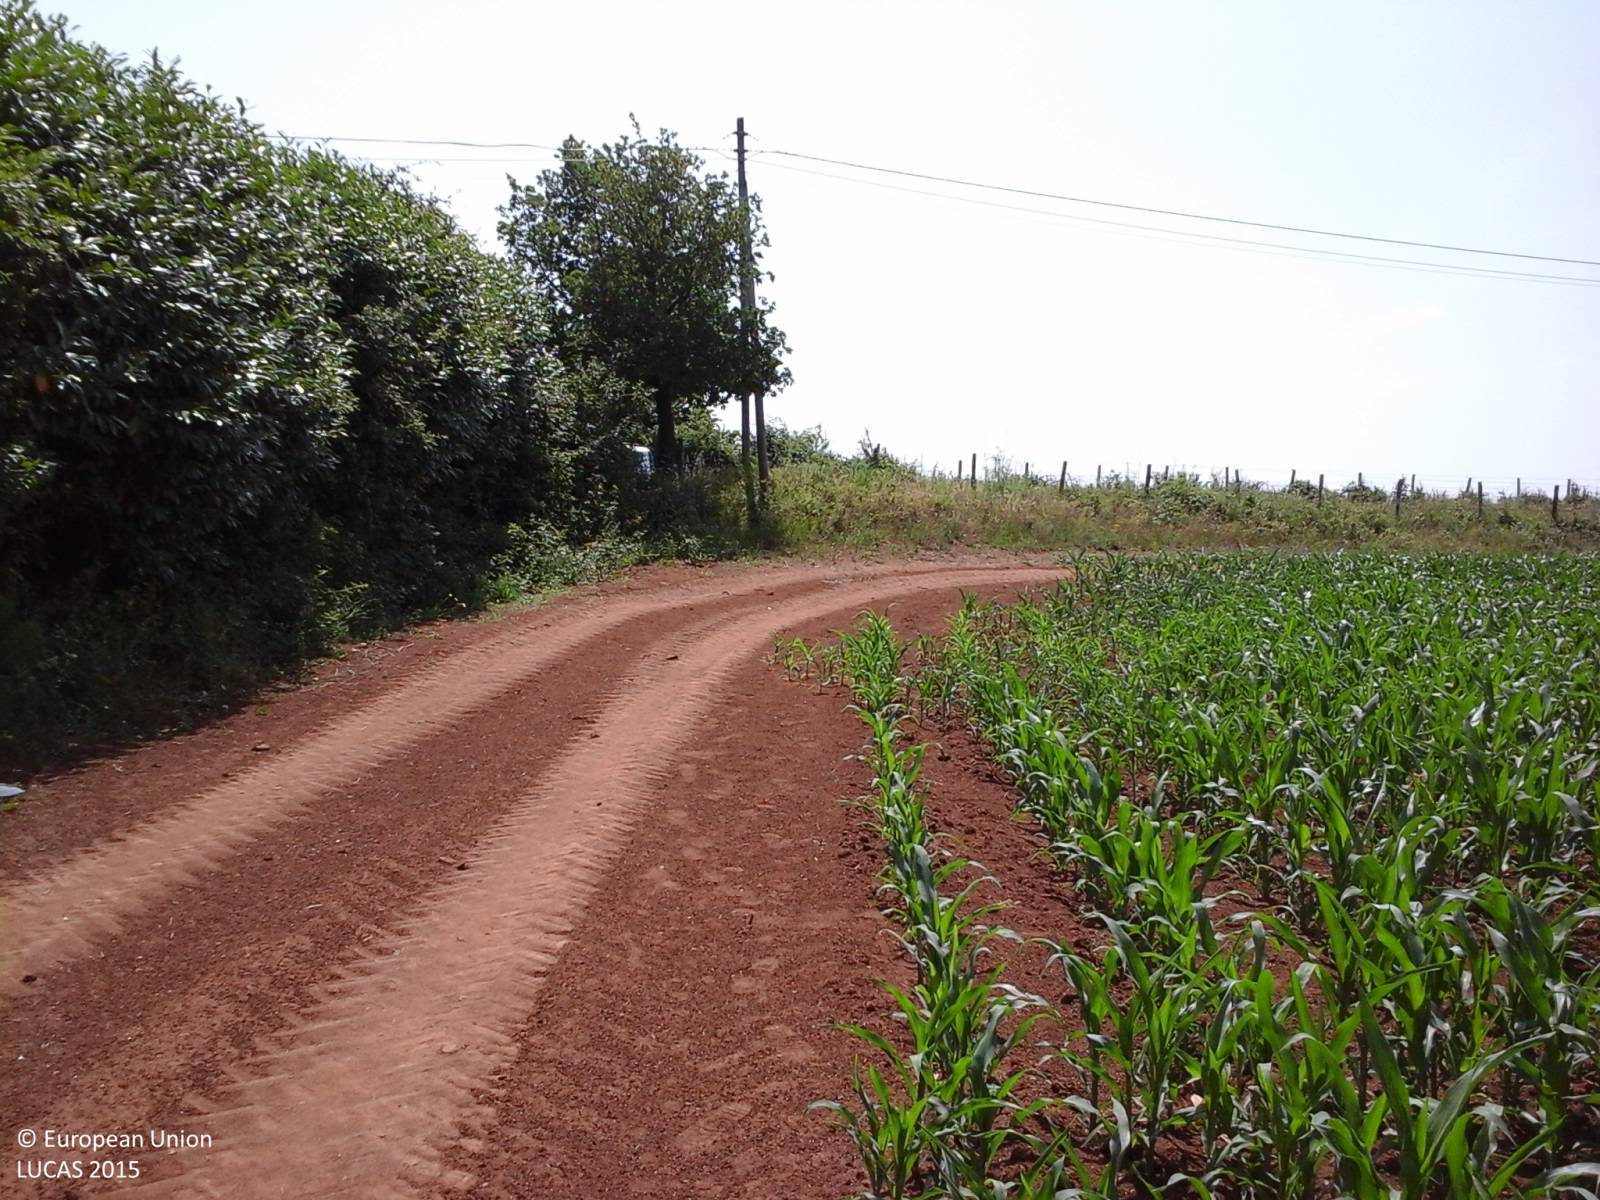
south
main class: Cropland
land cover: Maize
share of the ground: > 75 %
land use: Agriculture (excluding fallow land and kitchen gardens)
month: June
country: IT
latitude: 42.4480
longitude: 12.2660
